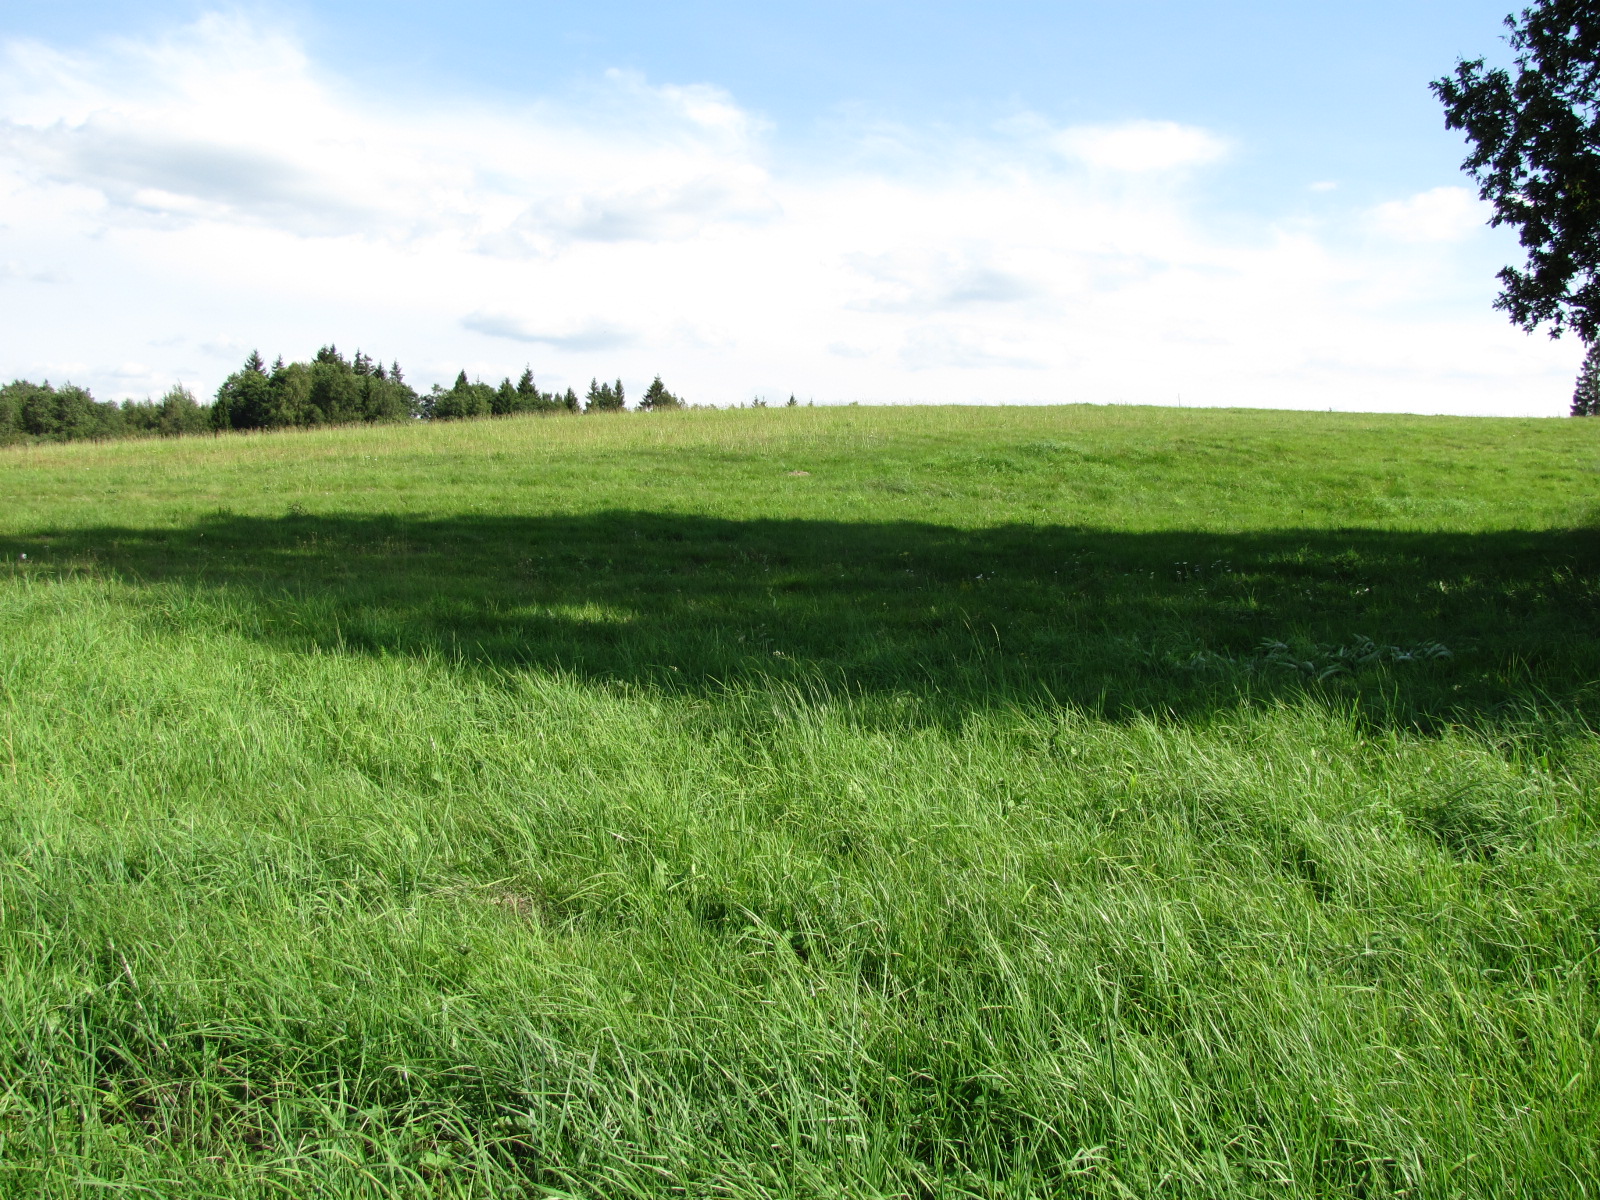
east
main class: Grassland
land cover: Grassland without tree/shrub cover
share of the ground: > 75 %
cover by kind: herbaceous plants 100 %
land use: Agriculture (excluding fallow land and kitchen gardens)
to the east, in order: Grassland without tree/shrub cover; Electric lines; Grassland without tree/shrub cover; Abandoned hedges; Ditches and canals; Spruce dominated mixed woodland
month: August
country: LV
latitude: 56.9904
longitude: 25.2702
